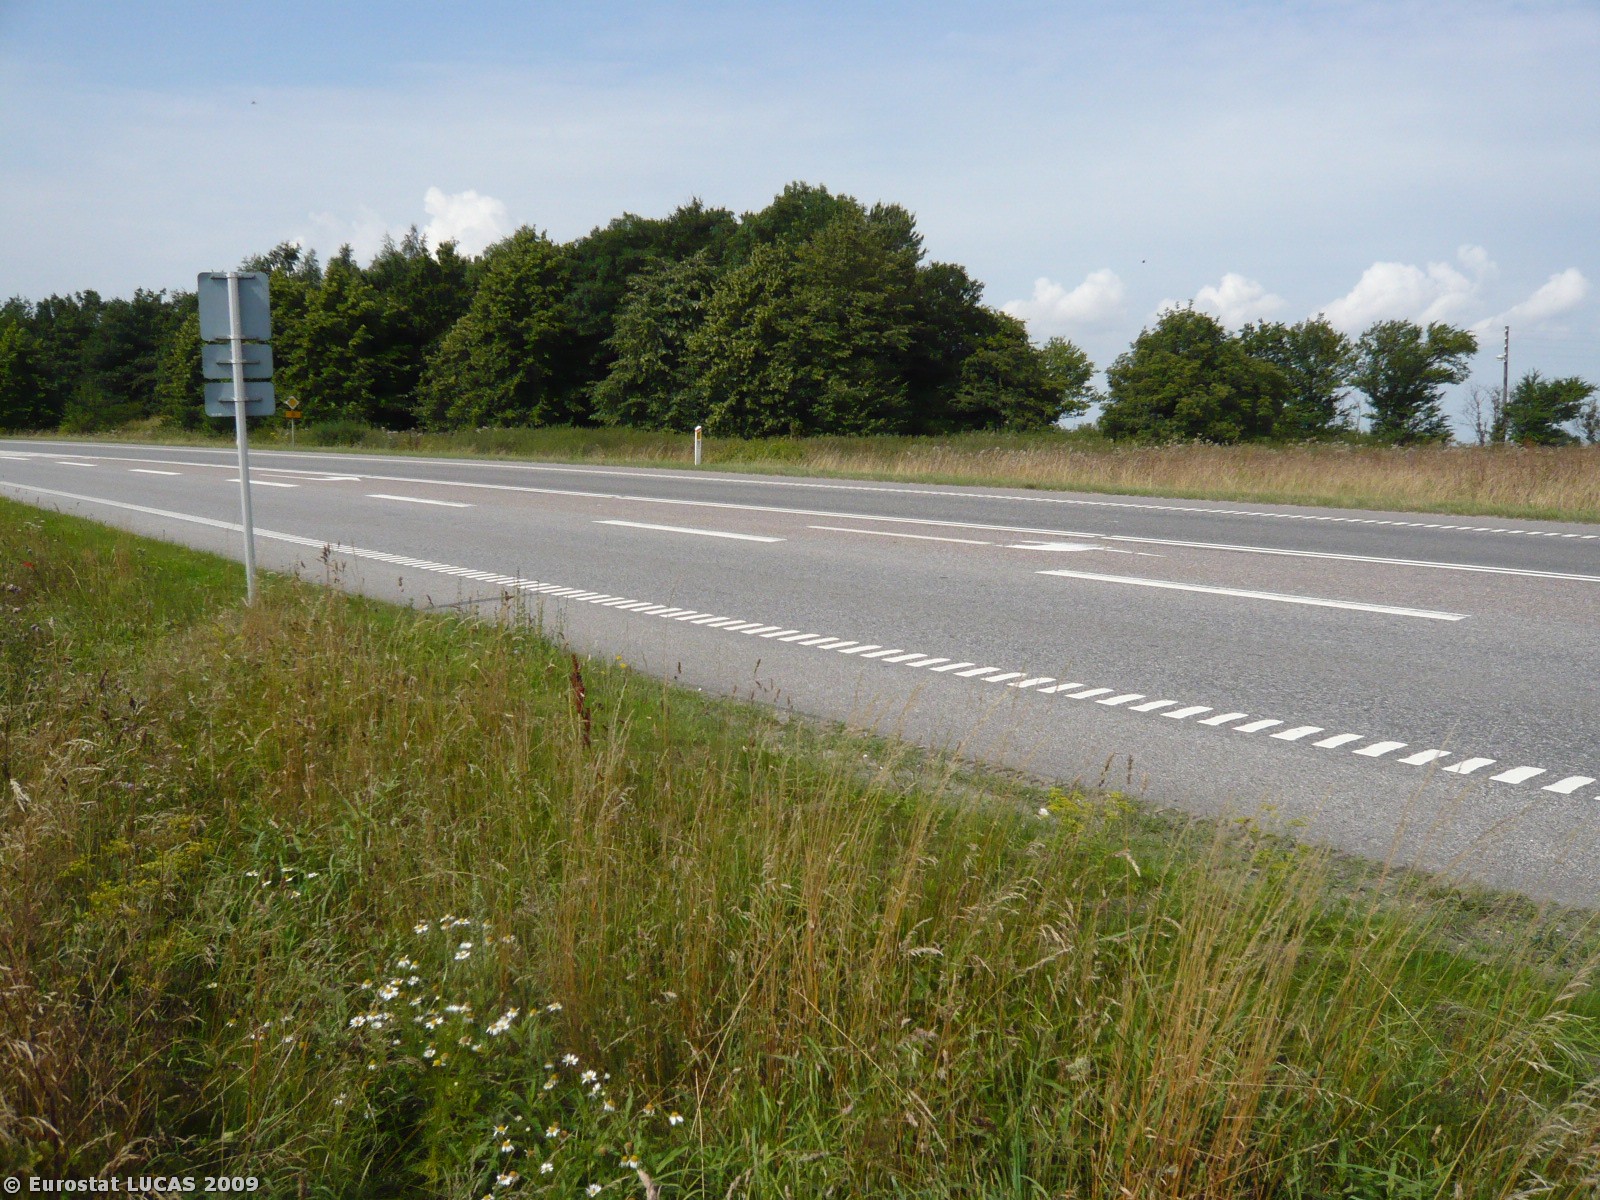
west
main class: Cropland
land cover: Common wheat
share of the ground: > 75 %
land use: Agriculture (excluding fallow land and kitchen gardens)
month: July
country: DK
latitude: 55.7741
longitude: 12.1502
